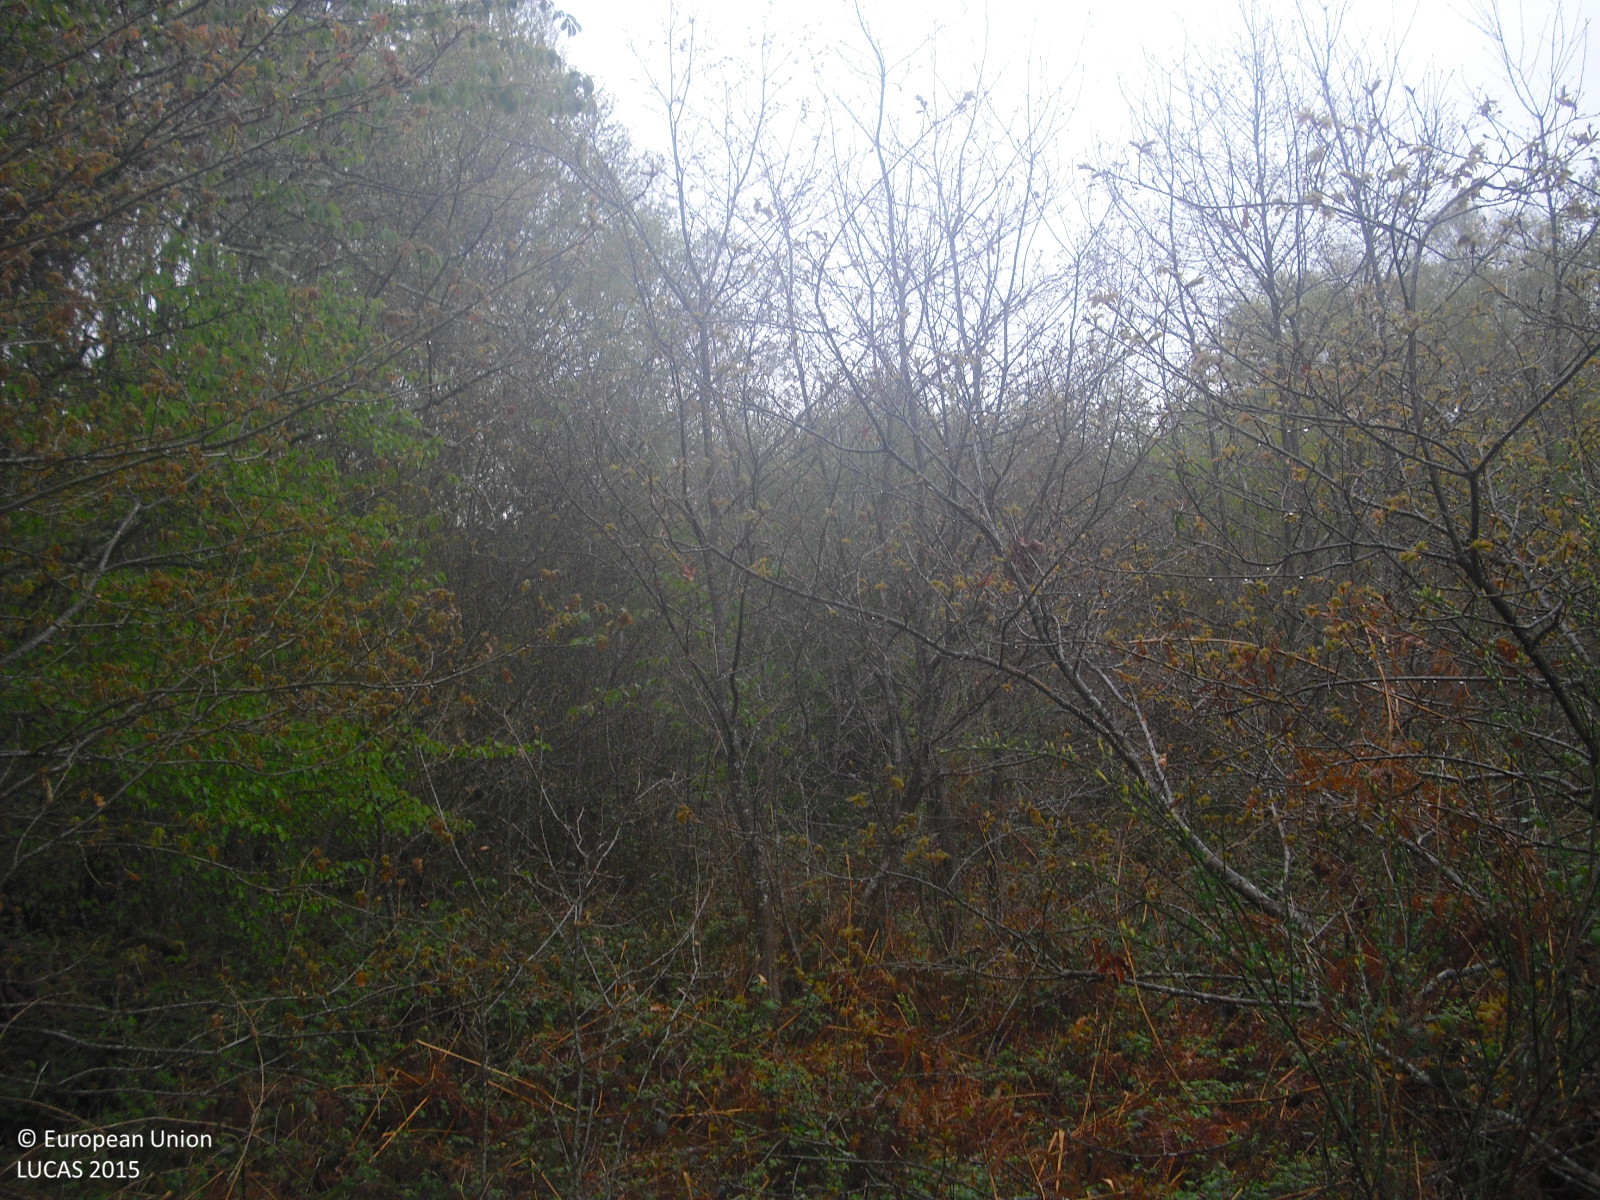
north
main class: Woodland
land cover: Broadleaved woodland
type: thermophilous deciduous forest
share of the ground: > 75 %
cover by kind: broadleaved forest trees 70 %, herbaceous plants 20 %, shrubs 10 %
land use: Forestry
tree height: > 5 m
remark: Clear cut
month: April
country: ES
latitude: 42.0768
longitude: -7.9034
